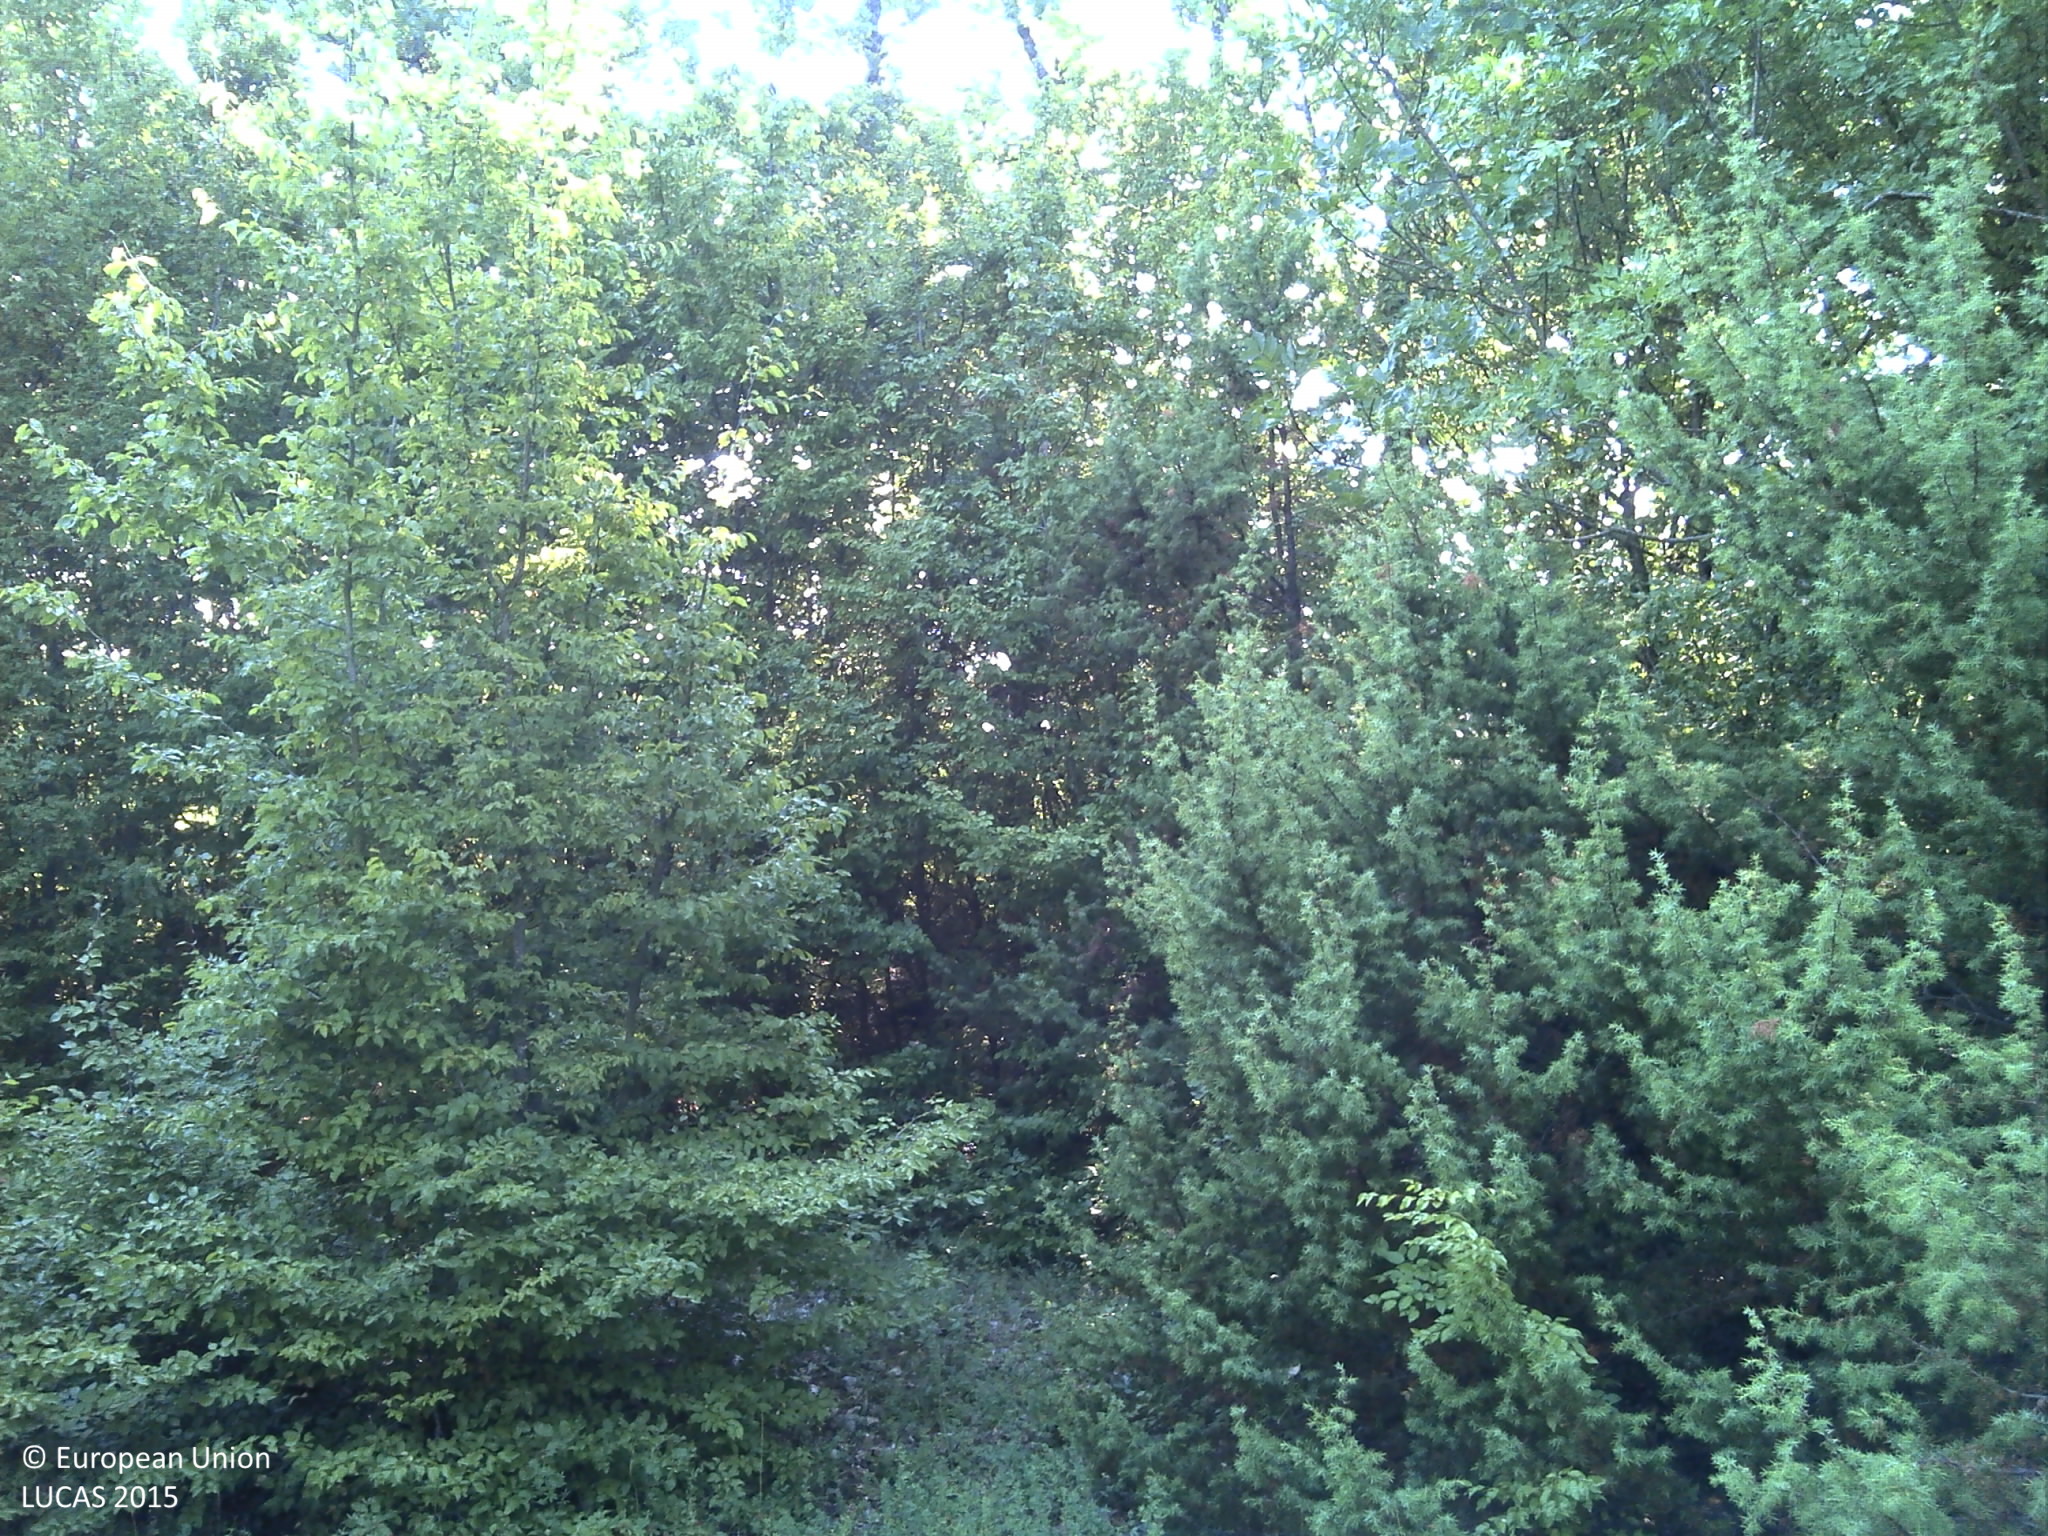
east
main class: Woodland
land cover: Other mixed woodland
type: thermophilous deciduous forest
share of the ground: > 75 %
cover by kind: broadleaved forest trees 30 %, shrubs 30 %, herbaceous plants 15 %, coniferous forest trees 10 %, unconsolidated bare surface 10 %, consolidated bare surface 5 %
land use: Semi-natural and natural areas not in use
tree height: > 5 m
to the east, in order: Other mixed woodland; Dry stone walls; Shrubland with sparse tree cover; Rock outcrops; Shrubland with sparse tree cover; Tracks; Shrubland with sparse tree cover; Rock outcrops; Shrubland with sparse tree cover; Rock outcrops; Shrubland with sparse tree cover; Broadleaved woodland
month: August
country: HR
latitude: 43.3427
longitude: 17.1582
